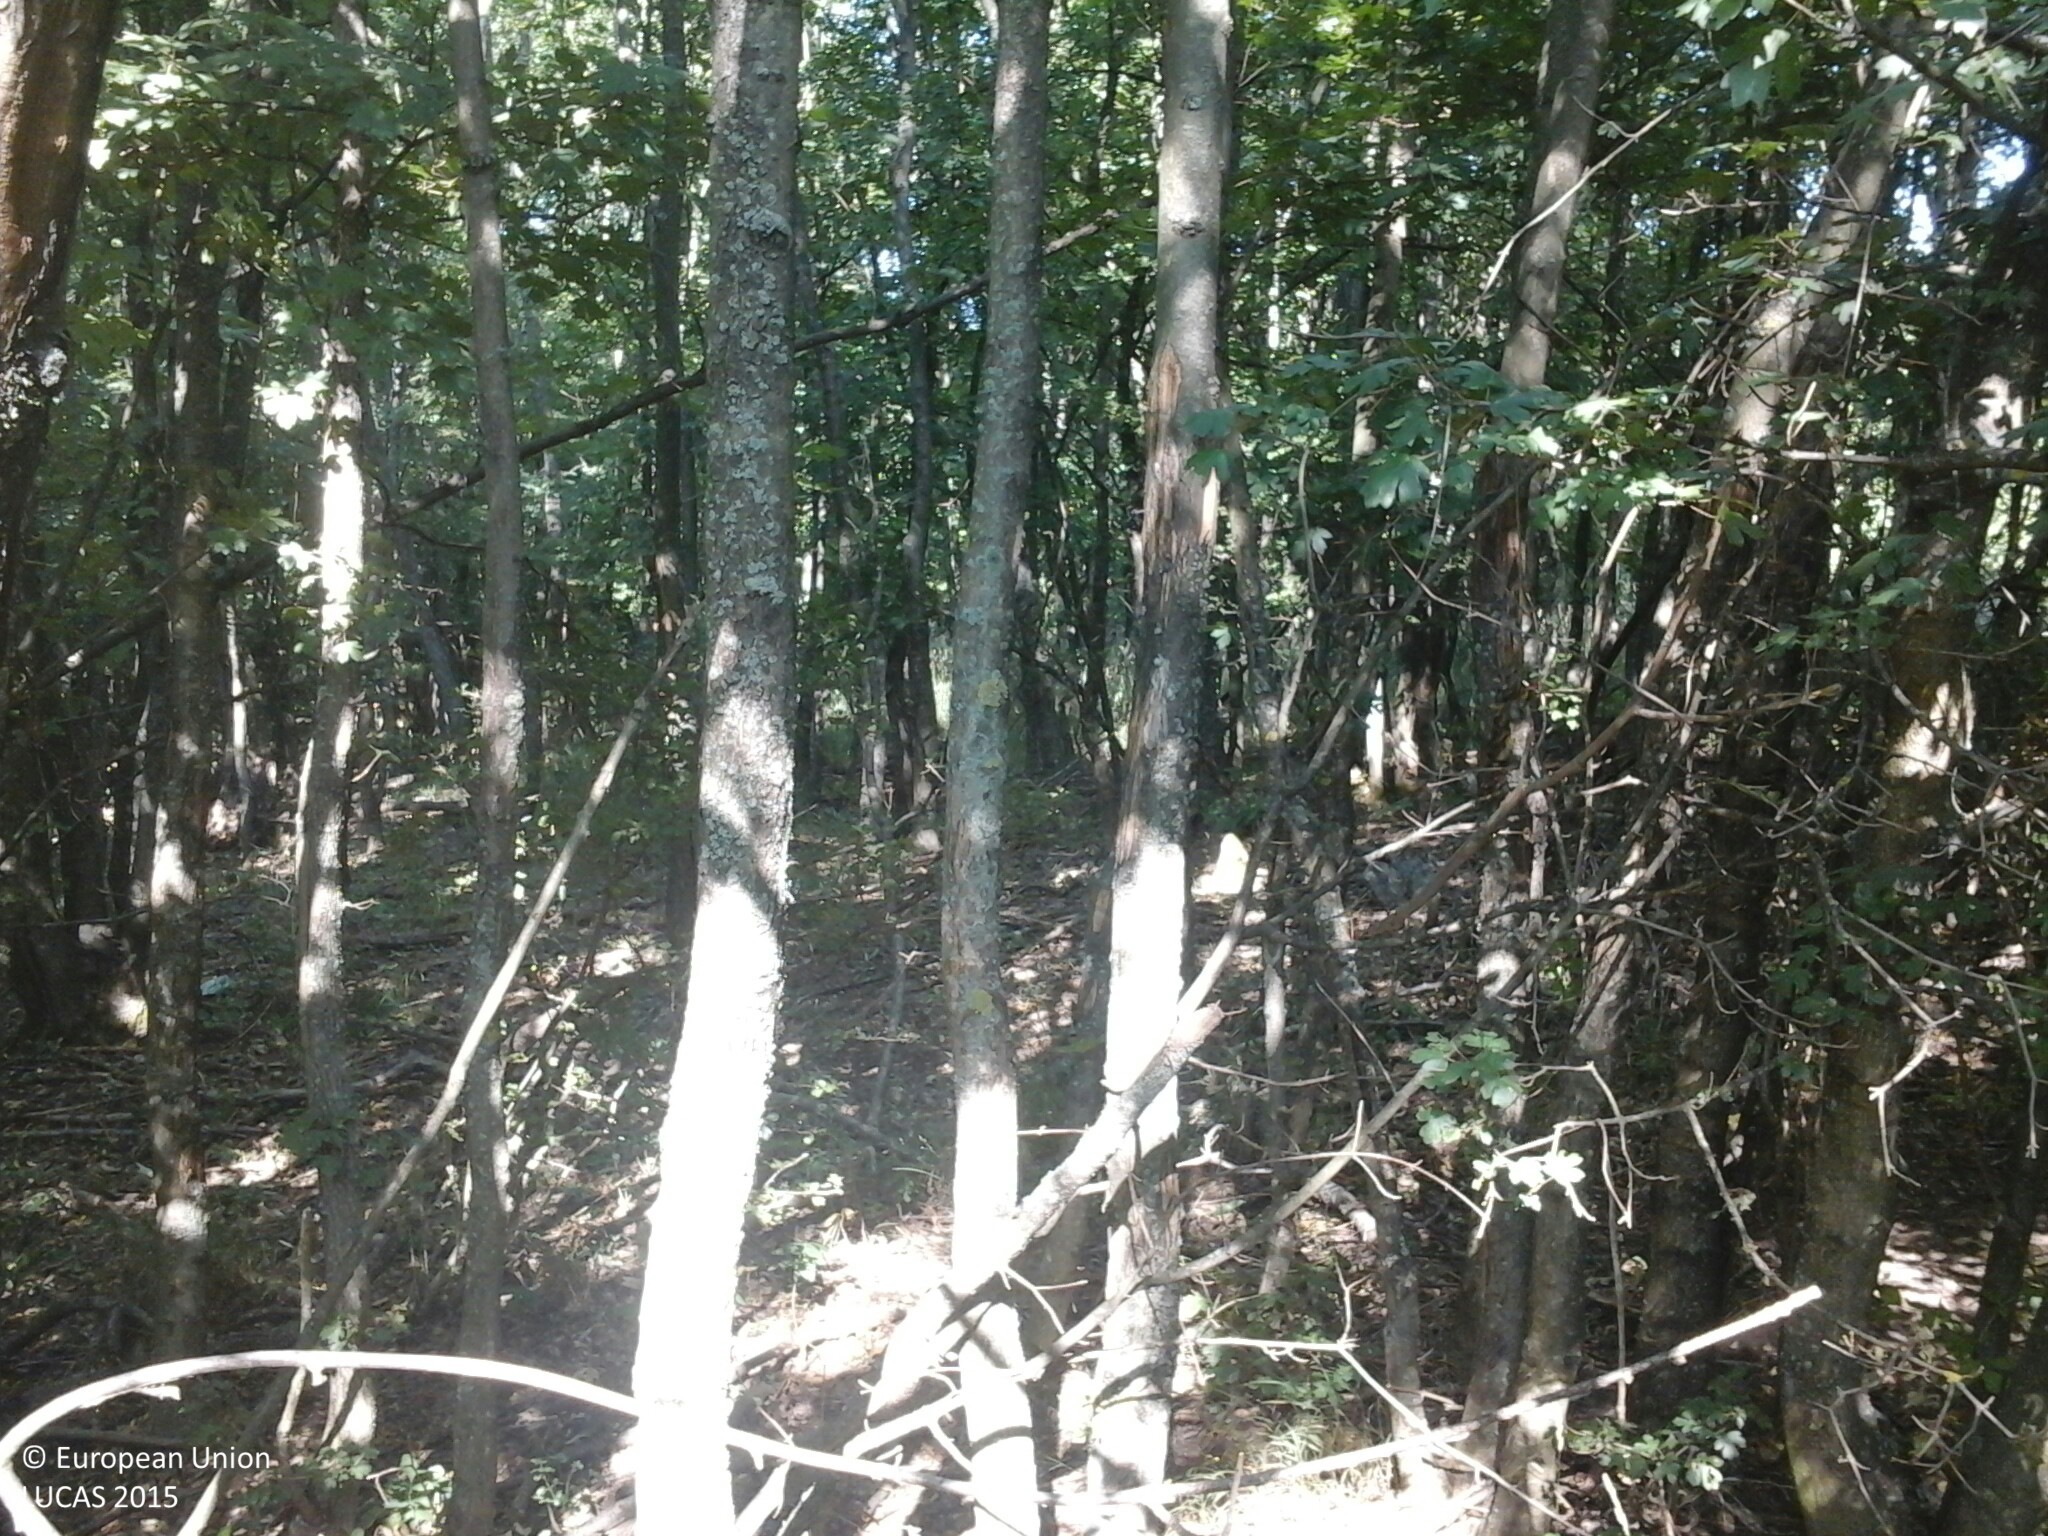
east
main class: Woodland
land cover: Broadleaved woodland
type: mesophytic deciduous forest
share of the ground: > 75 %
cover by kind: broadleaved forest trees 85 %, shrubs 10 %, herbaceous plants 5 %
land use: Forestry
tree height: < 5 m
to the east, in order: Broadleaved woodland; Tracks; Broadleaved woodland
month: July
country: HU
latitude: 47.2470
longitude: 17.9767
